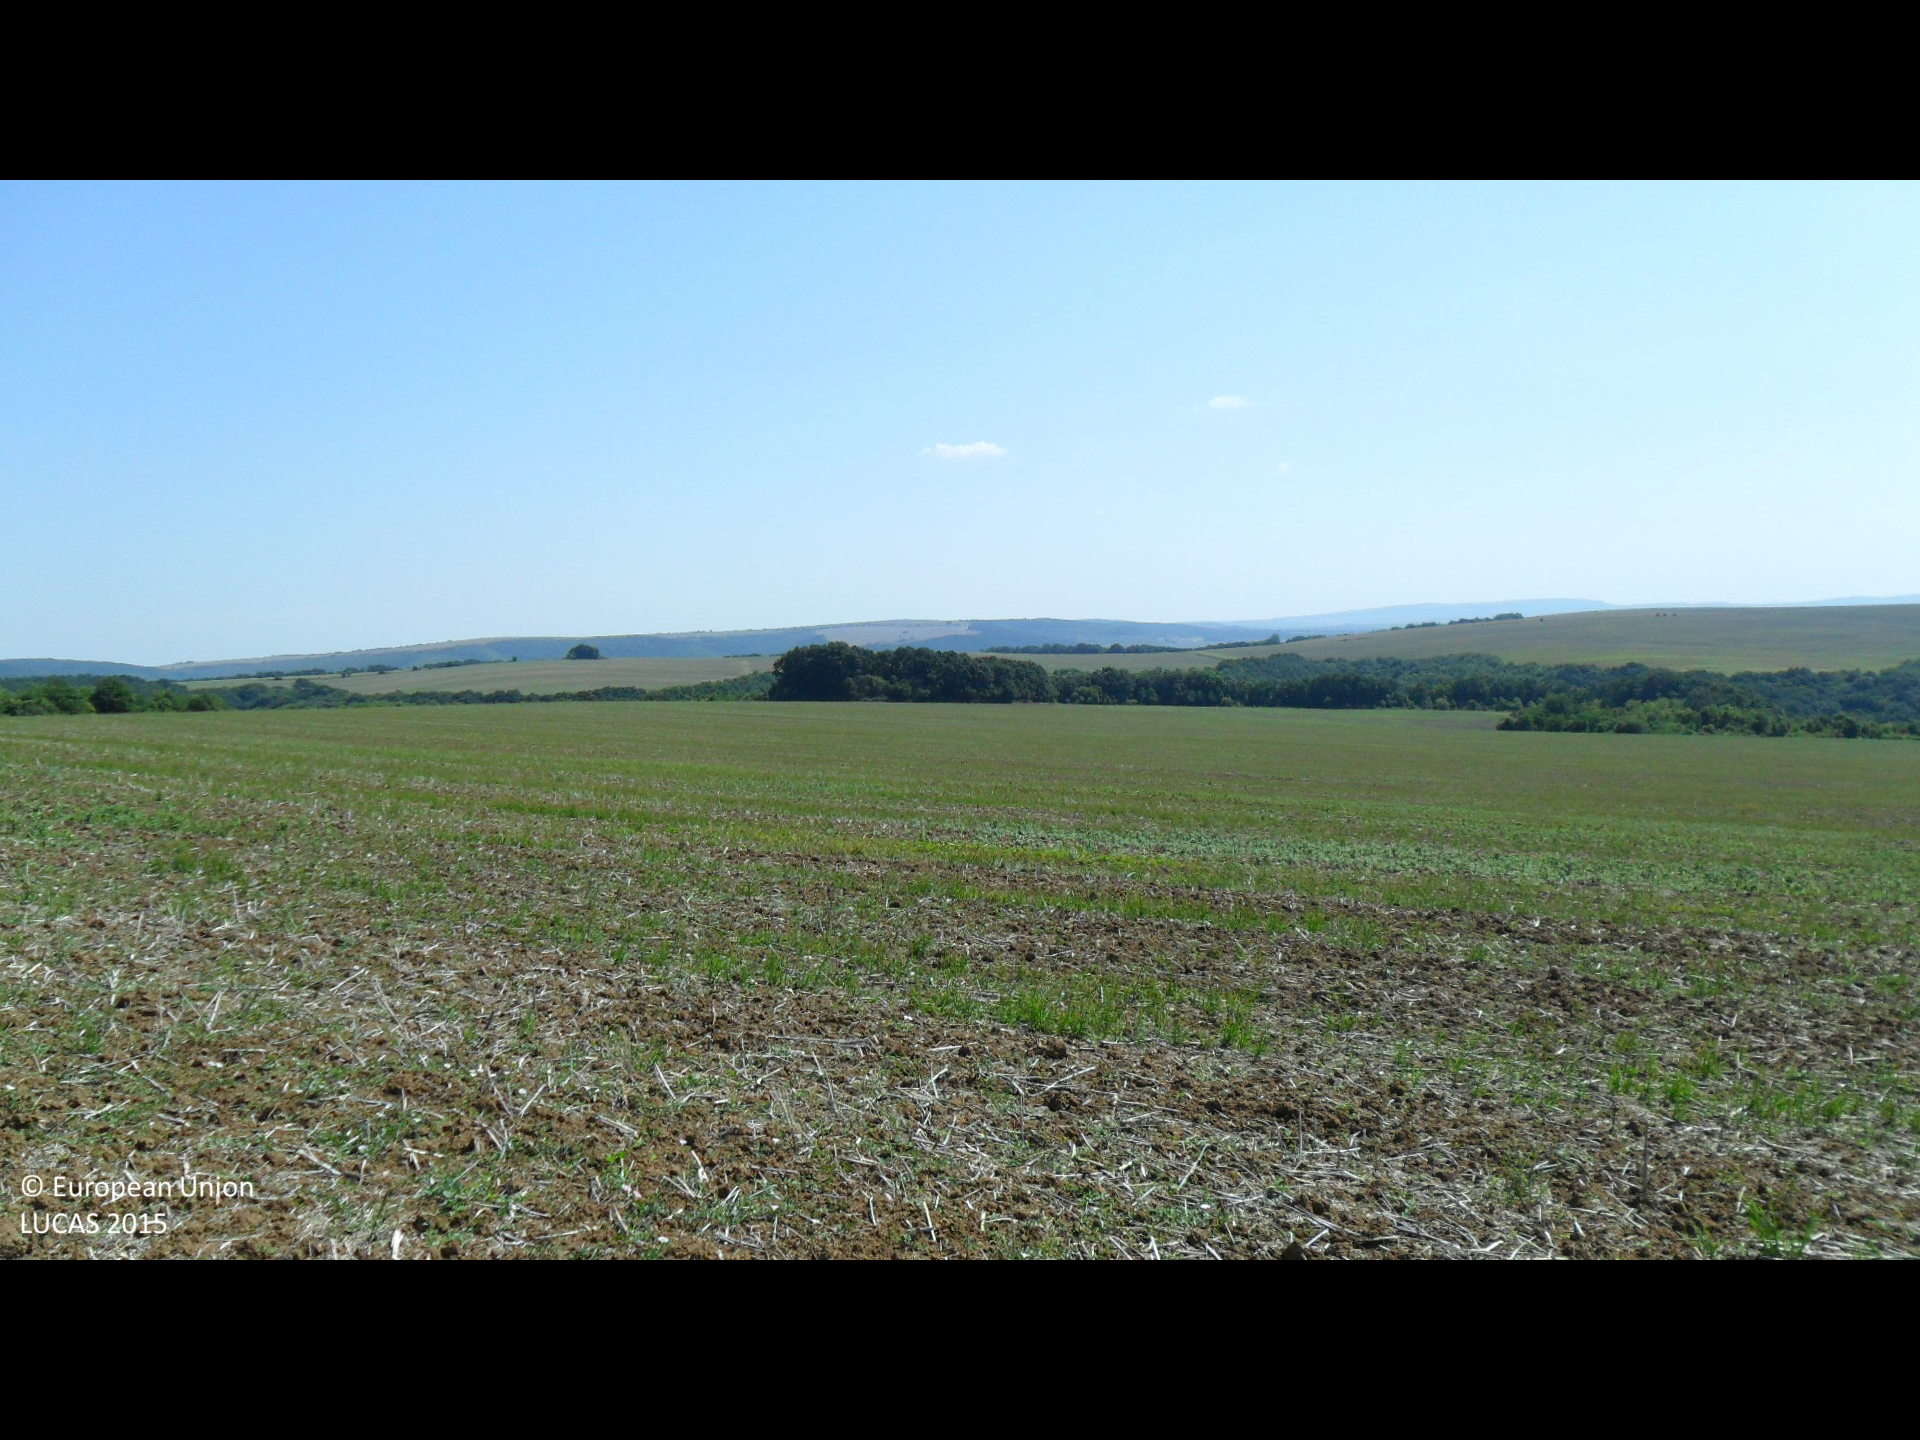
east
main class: Cropland
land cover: Rape and turnip rape
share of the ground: < 10 %
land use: Agriculture (excluding fallow land and kitchen gardens)
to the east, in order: Rape and turnip rape
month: August
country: BG
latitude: 43.5021
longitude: 26.2384
